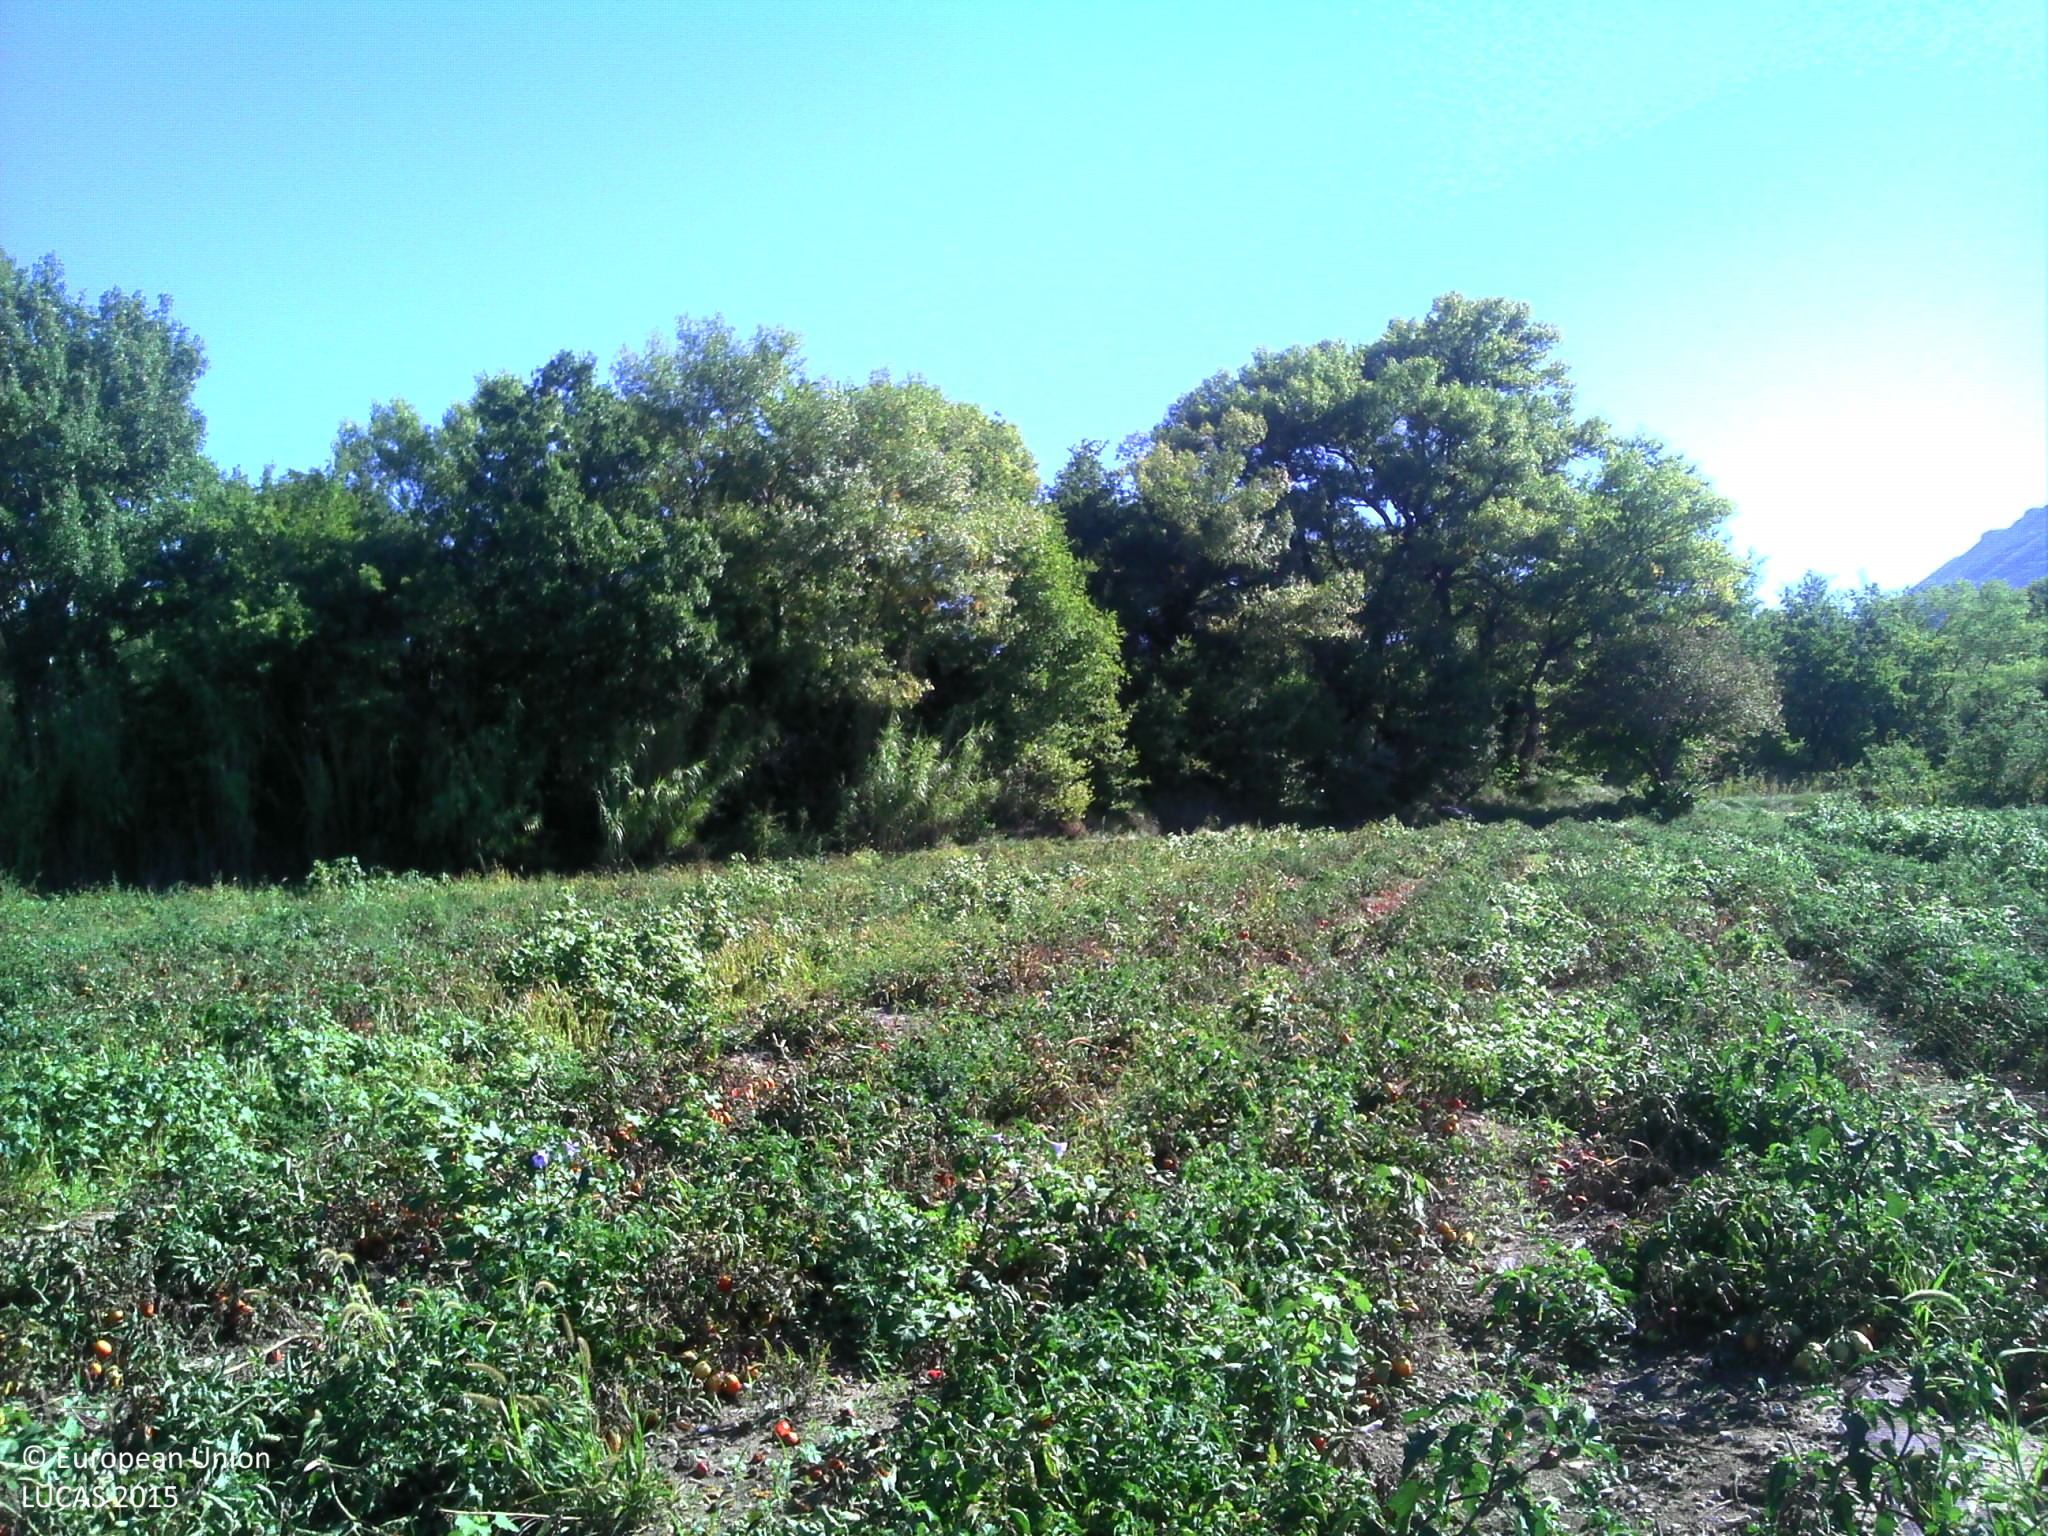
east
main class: Cropland
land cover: Tomatoes
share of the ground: > 75 %
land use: Agriculture (excluding fallow land and kitchen gardens)
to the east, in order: Tomatoes; Grassland without tree/shrub cover; Ditches and canals; Broadleaved woodland; Inland fresh running water; Broadleaved woodland
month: September
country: FR
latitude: 44.2377
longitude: 5.1621
